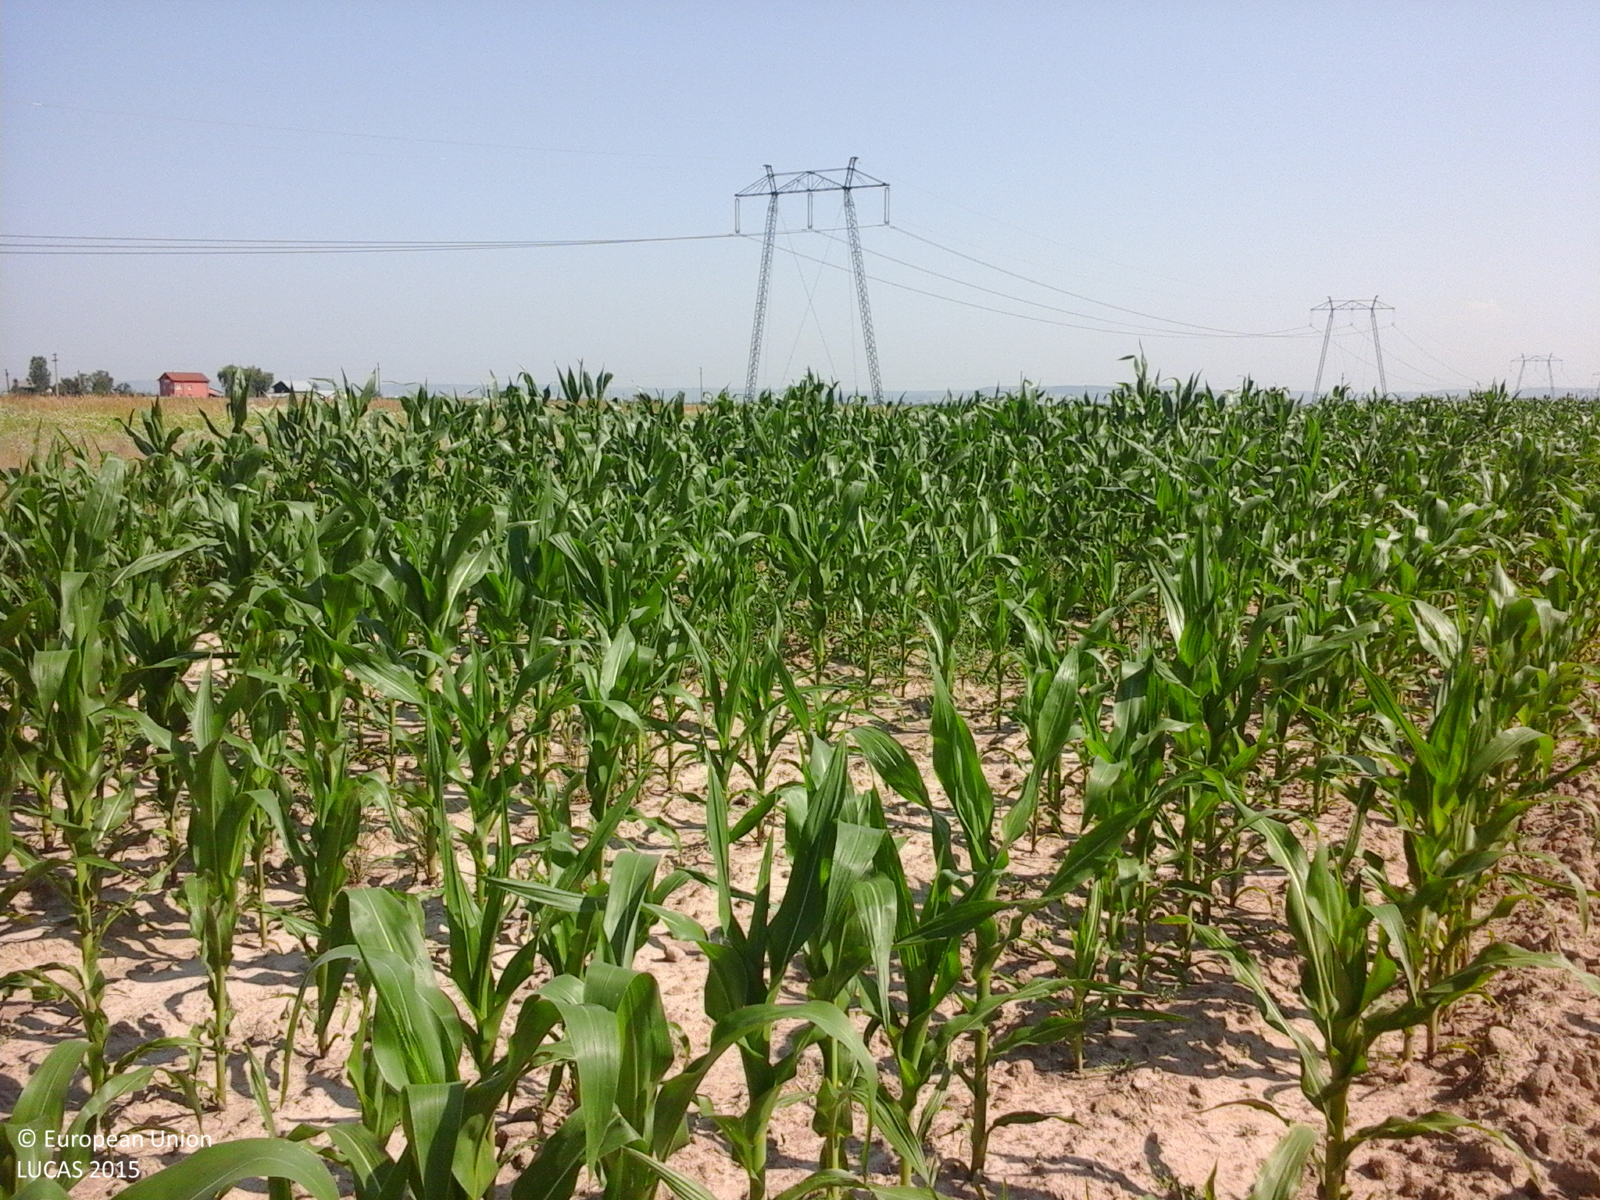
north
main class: Cropland
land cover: Maize
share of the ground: 50 - 75 %
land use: Agriculture (excluding fallow land and kitchen gardens)
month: July
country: RO
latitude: 44.7547
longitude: 25.0019
